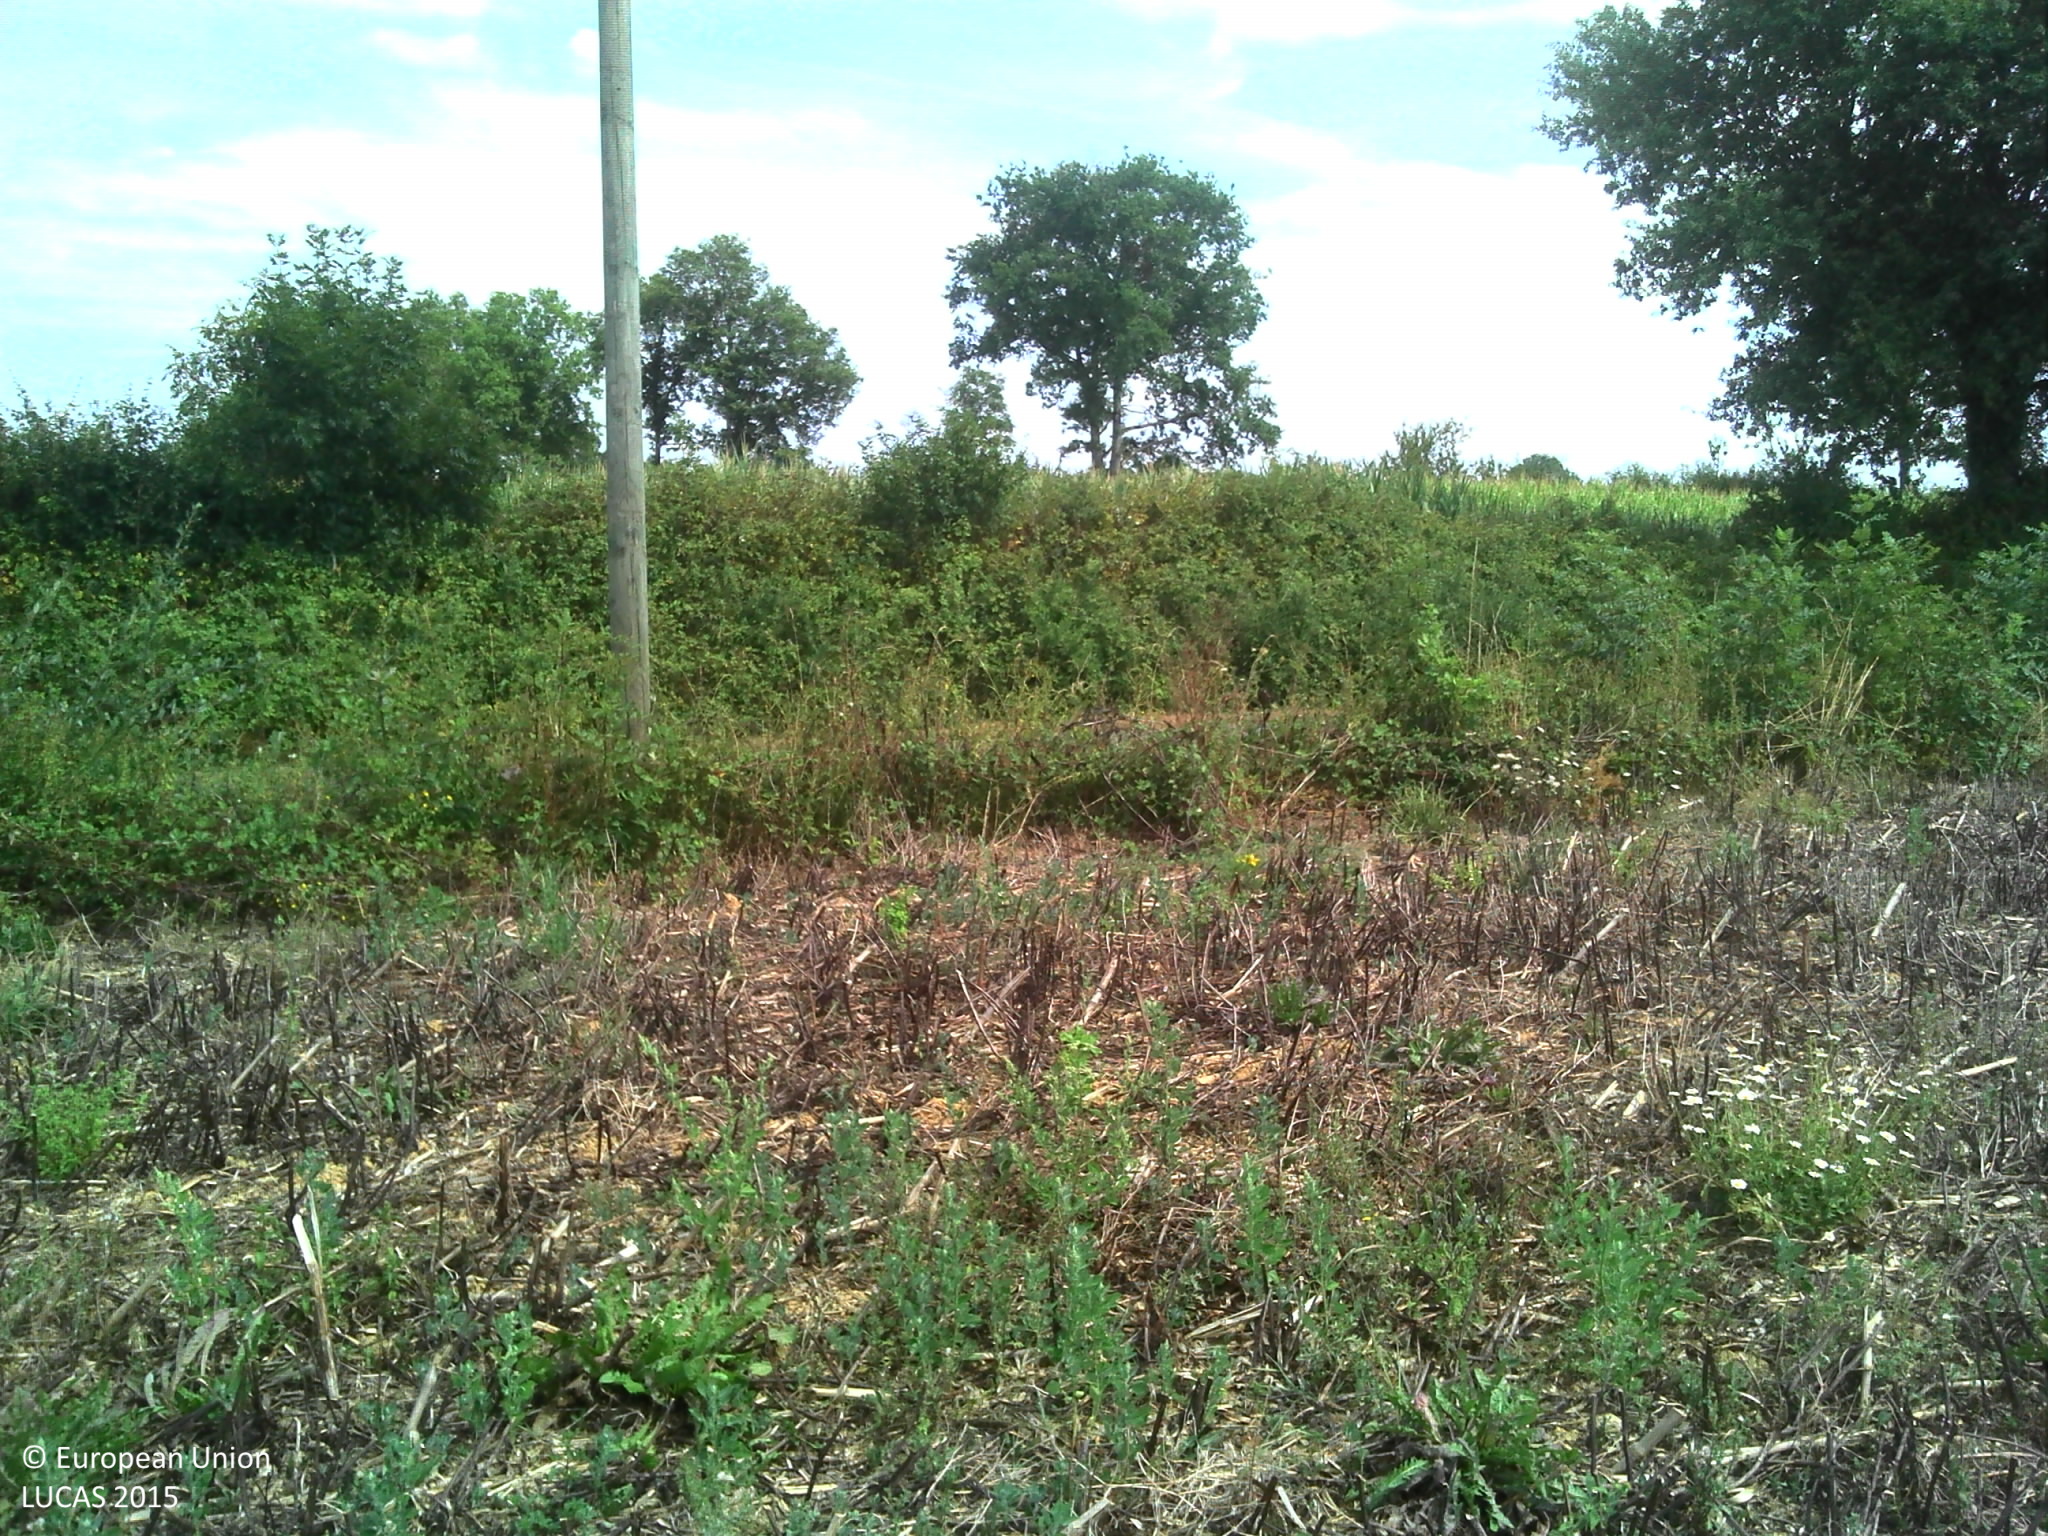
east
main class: Cropland
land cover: Dry pulses
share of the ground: > 75 %
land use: Agriculture (excluding fallow land and kitchen gardens)
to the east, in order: Dry pulses; Ditches and canals; Electric lines; Grass margins; Paved roads, cycling and walking lanes; Grass margins; Ditches and canals; Abandoned hedges; Maize; Lines of trees; Ditches and canals; Grassland without tree/shrub cover
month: August
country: FR
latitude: 46.6288
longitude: -1.0699
